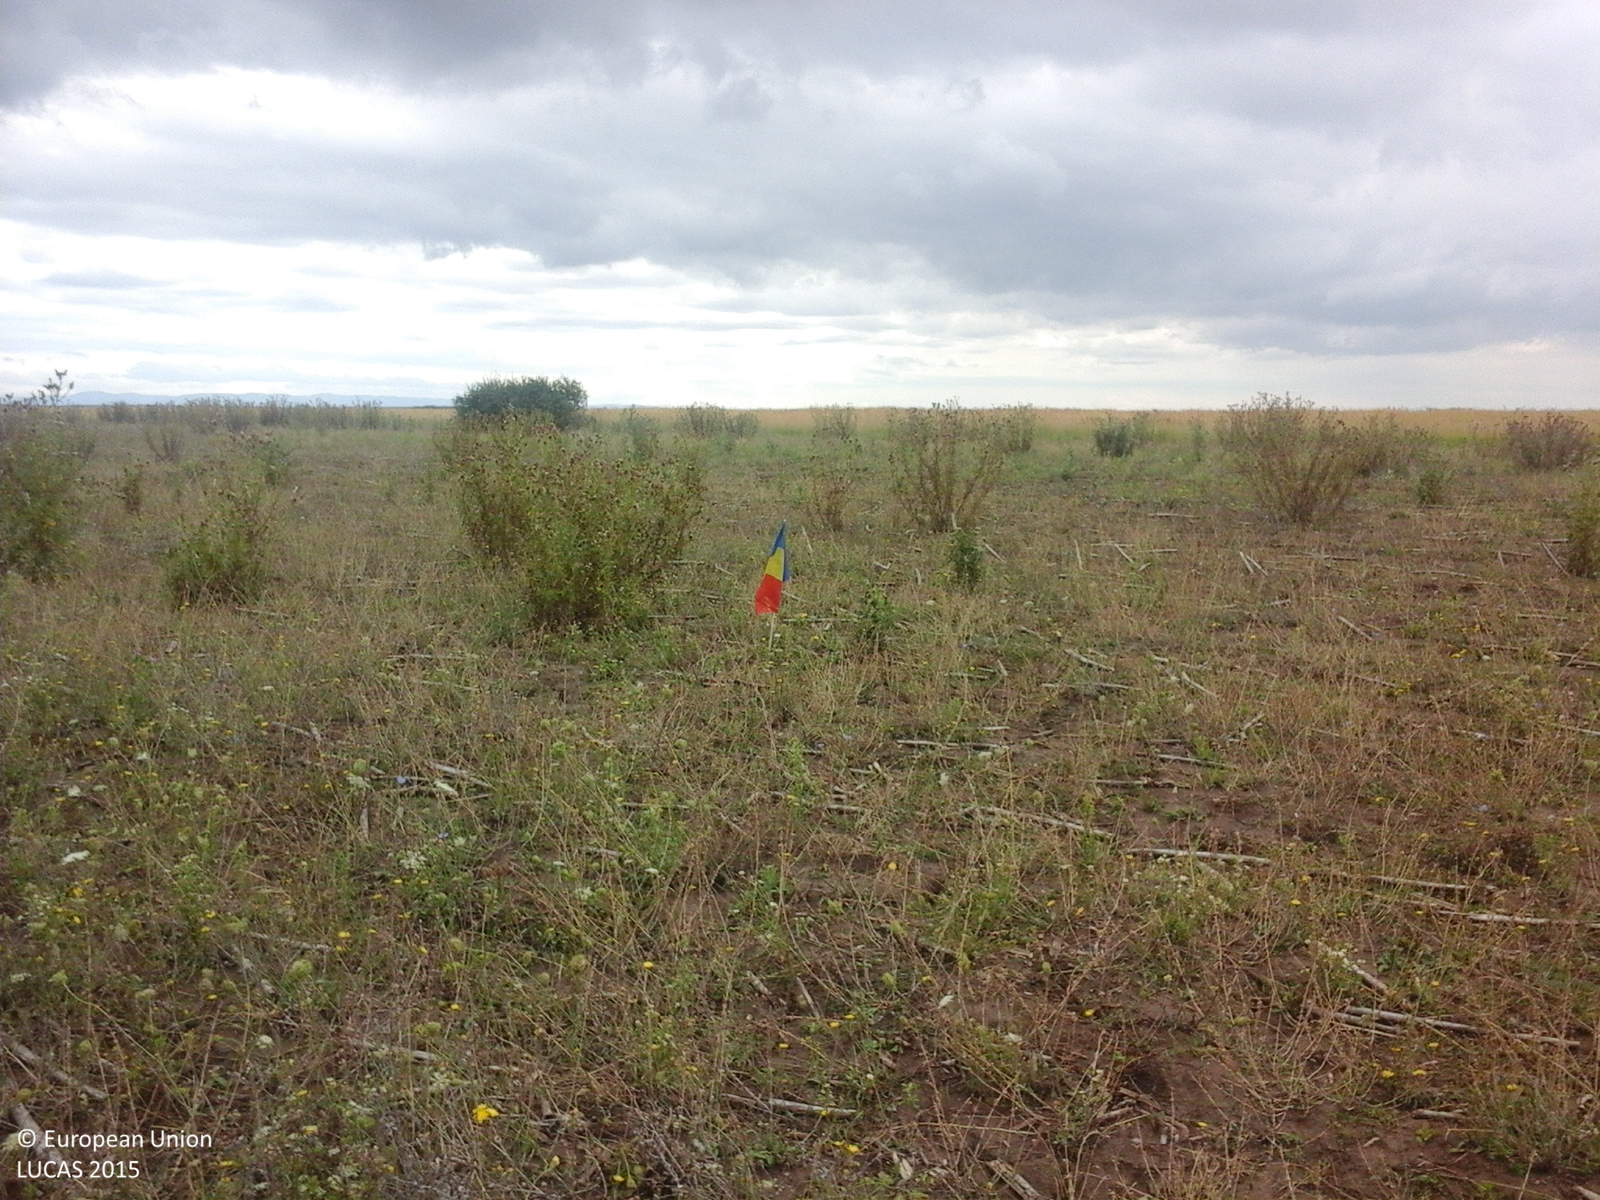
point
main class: Grassland
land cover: Spontaneously vegetated surfaces
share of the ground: > 75 %
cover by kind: herbaceous plants 100 %
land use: Agriculture (excluding fallow land and kitchen gardens)
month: August
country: RO
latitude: 45.5623
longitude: 21.5251
